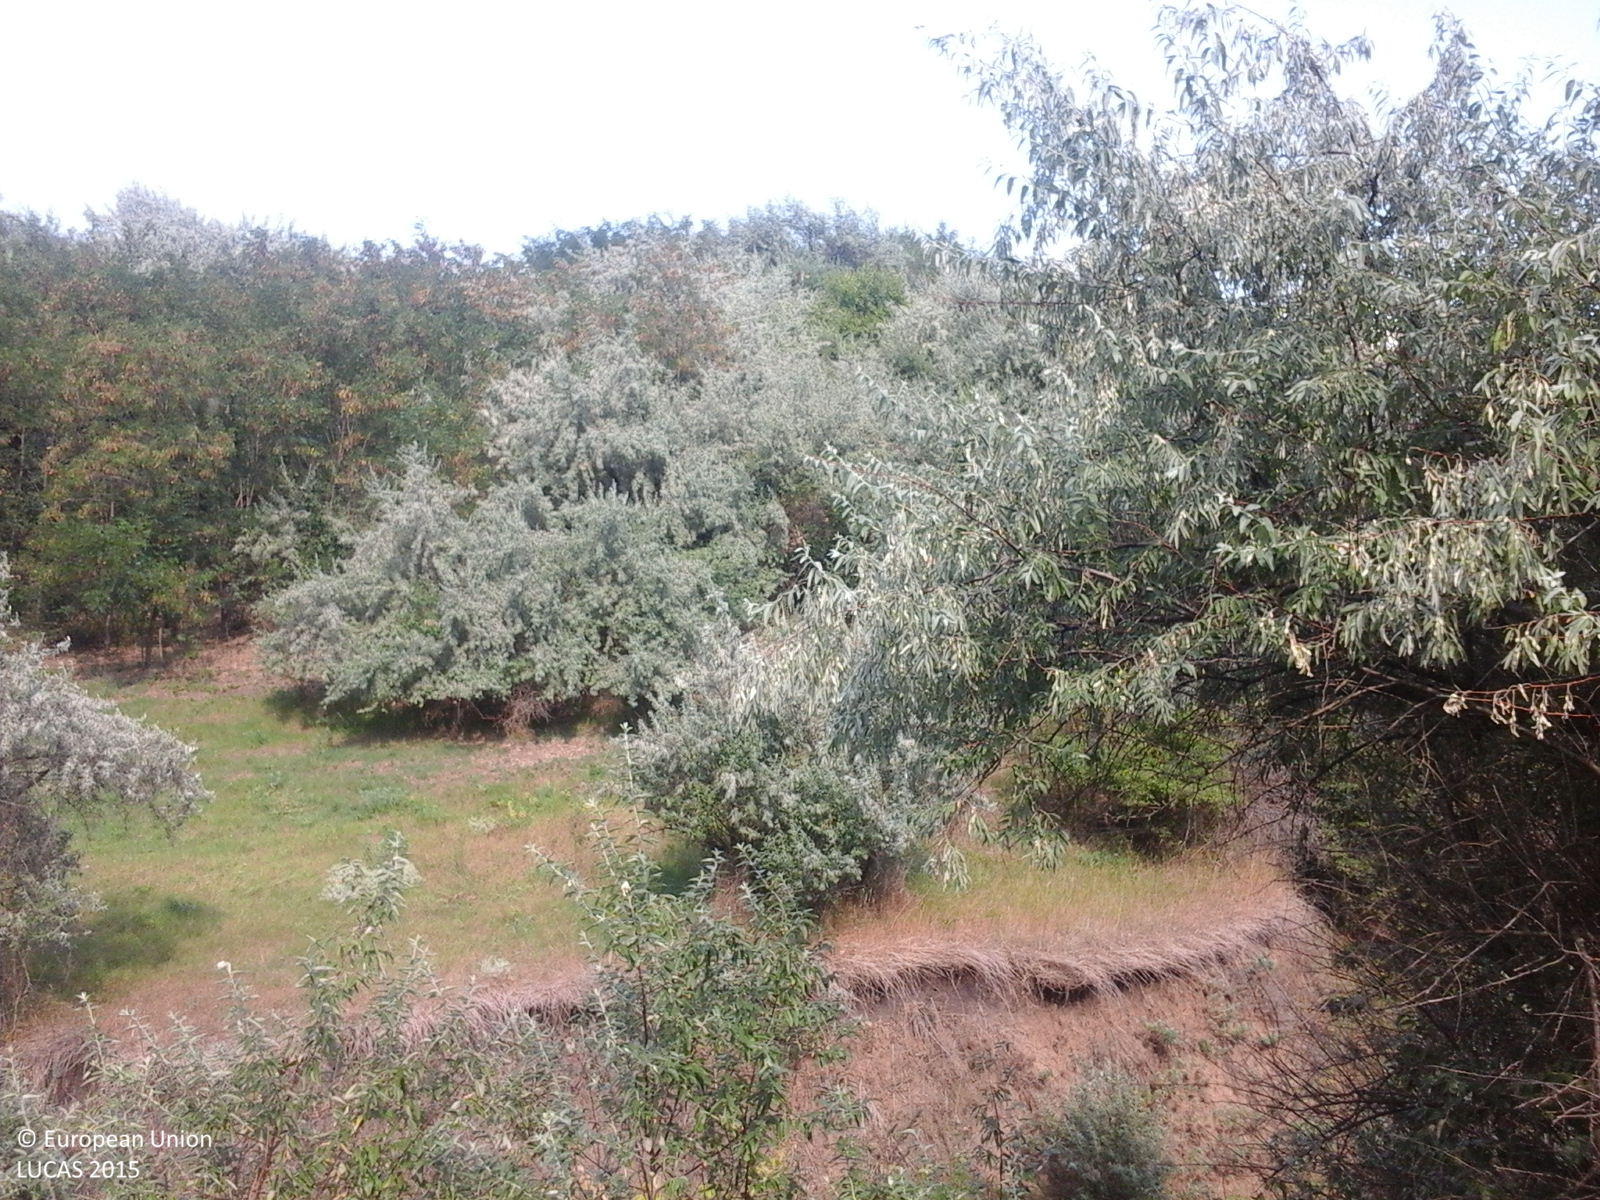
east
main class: Shrubland
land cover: Shrubland with sparse tree cover
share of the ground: > 75 %
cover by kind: herbaceous plants 80 %, shrubs 15 %, broadleaved forest trees 5 %
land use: Semi-natural and natural areas not in use
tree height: < 5 m
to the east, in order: Shrubland with sparse tree cover; Ditches and canals; Shrubland with sparse tree cover; Broadleaved woodland
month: July
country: RO
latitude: 45.8874
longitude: 28.0476
